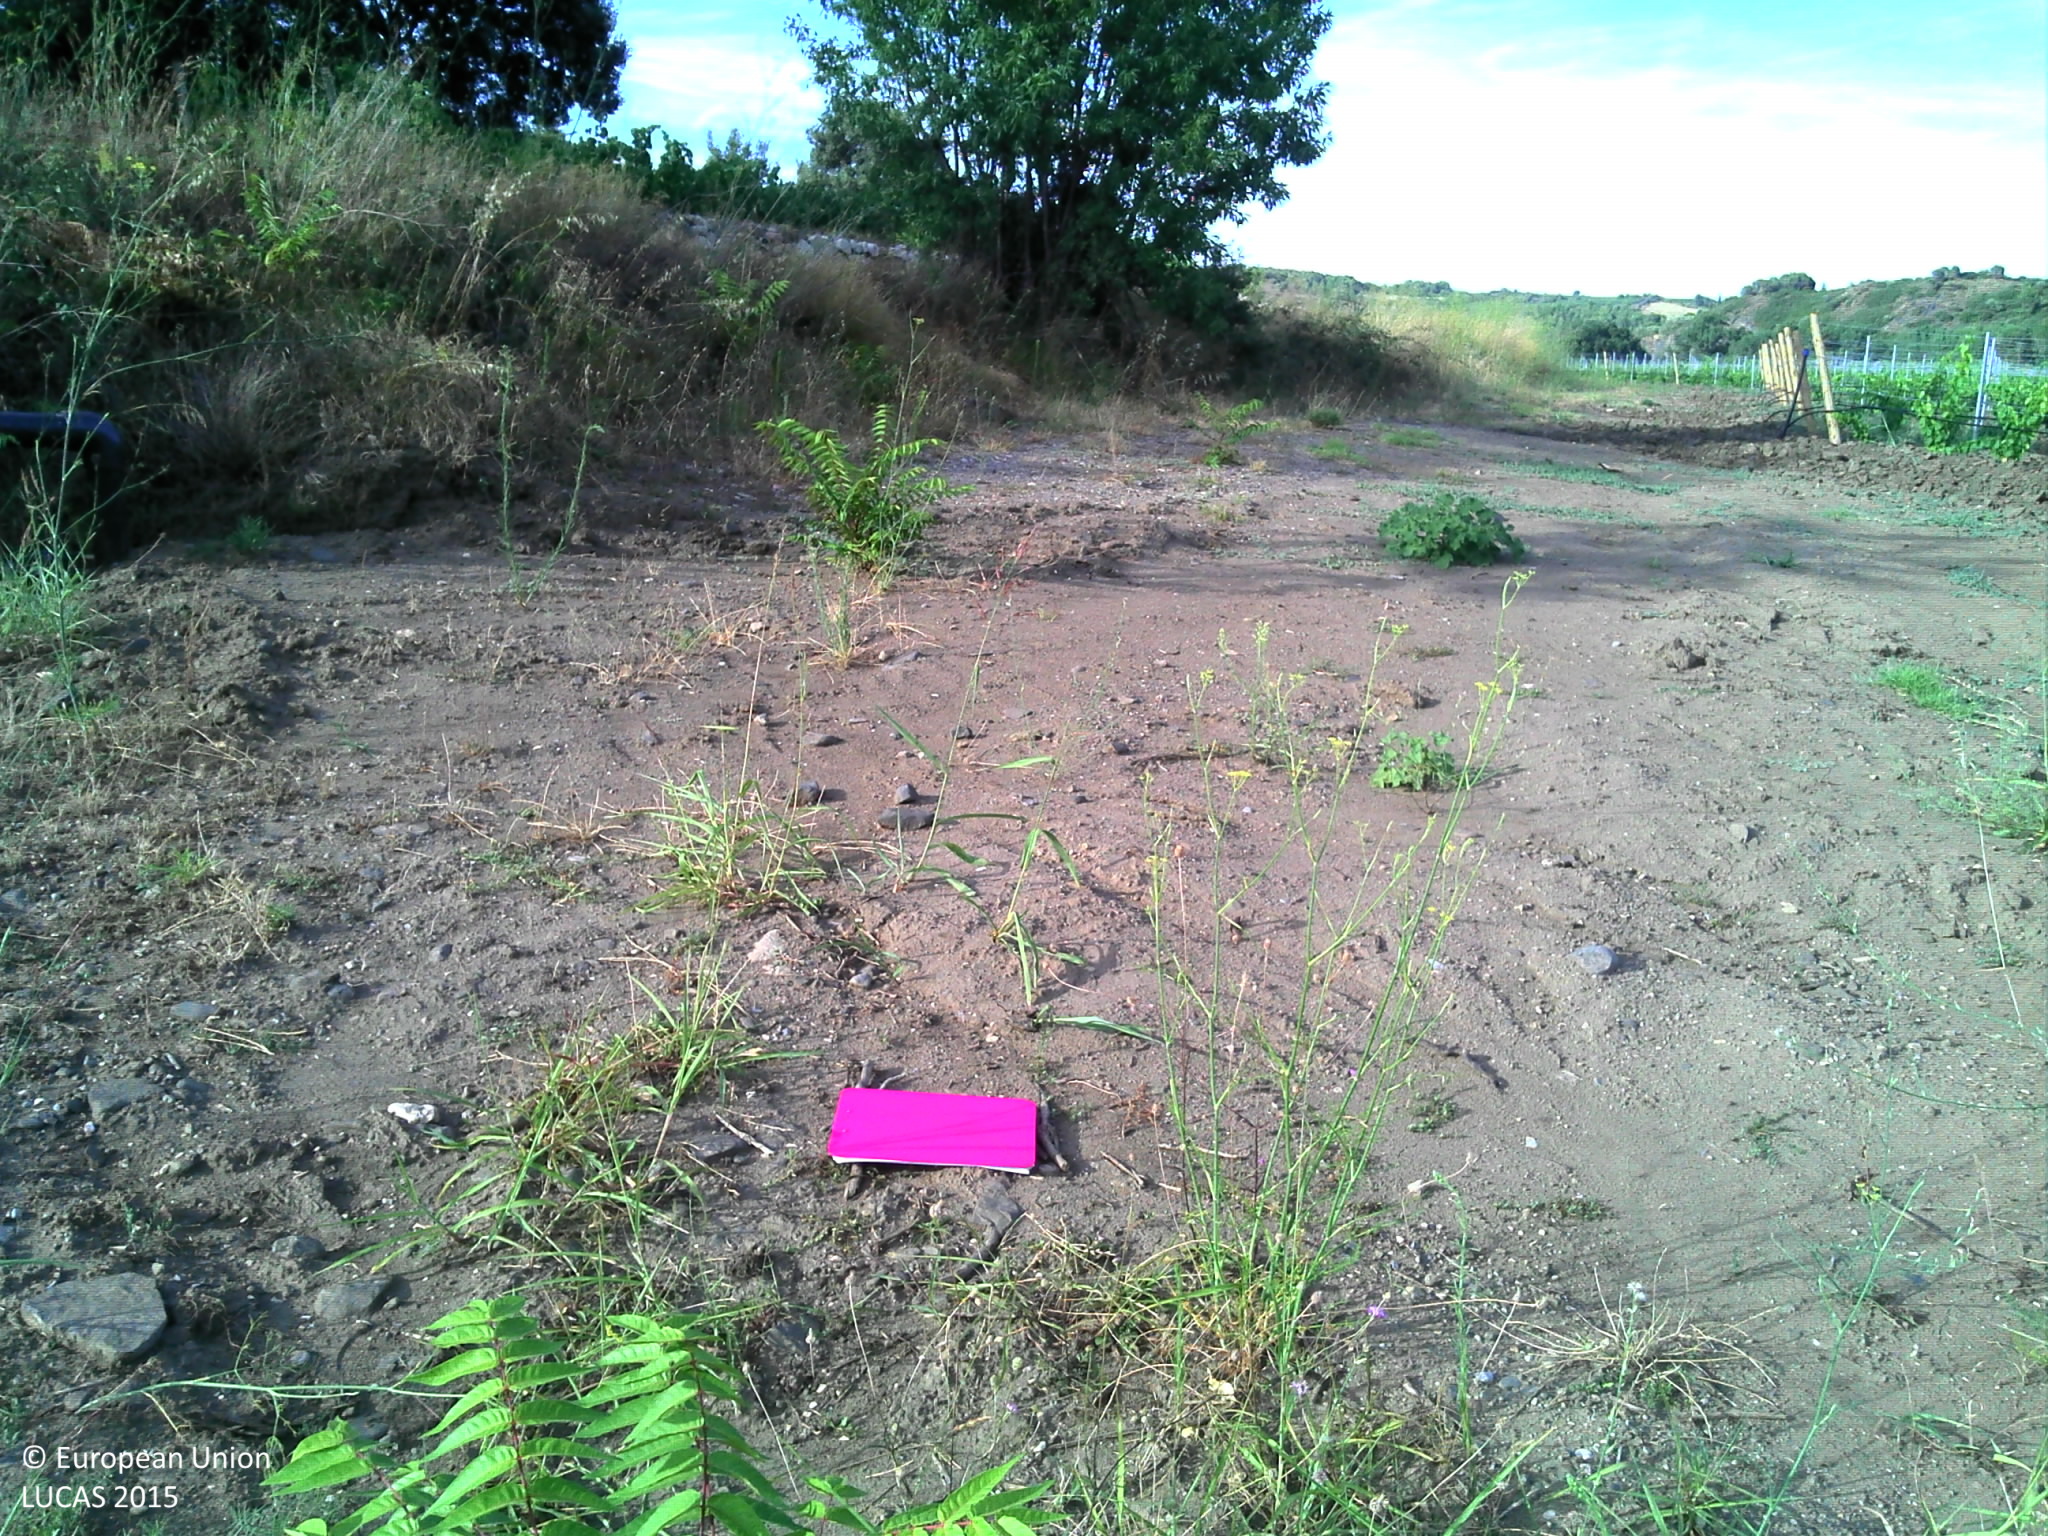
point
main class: Grassland
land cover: Spontaneously vegetated surfaces
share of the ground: > 75 %
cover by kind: unconsolidated bare surface 70 %, herbaceous plants 30 %
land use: Fallow land
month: July
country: FR
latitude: 42.7756
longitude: 2.7634
